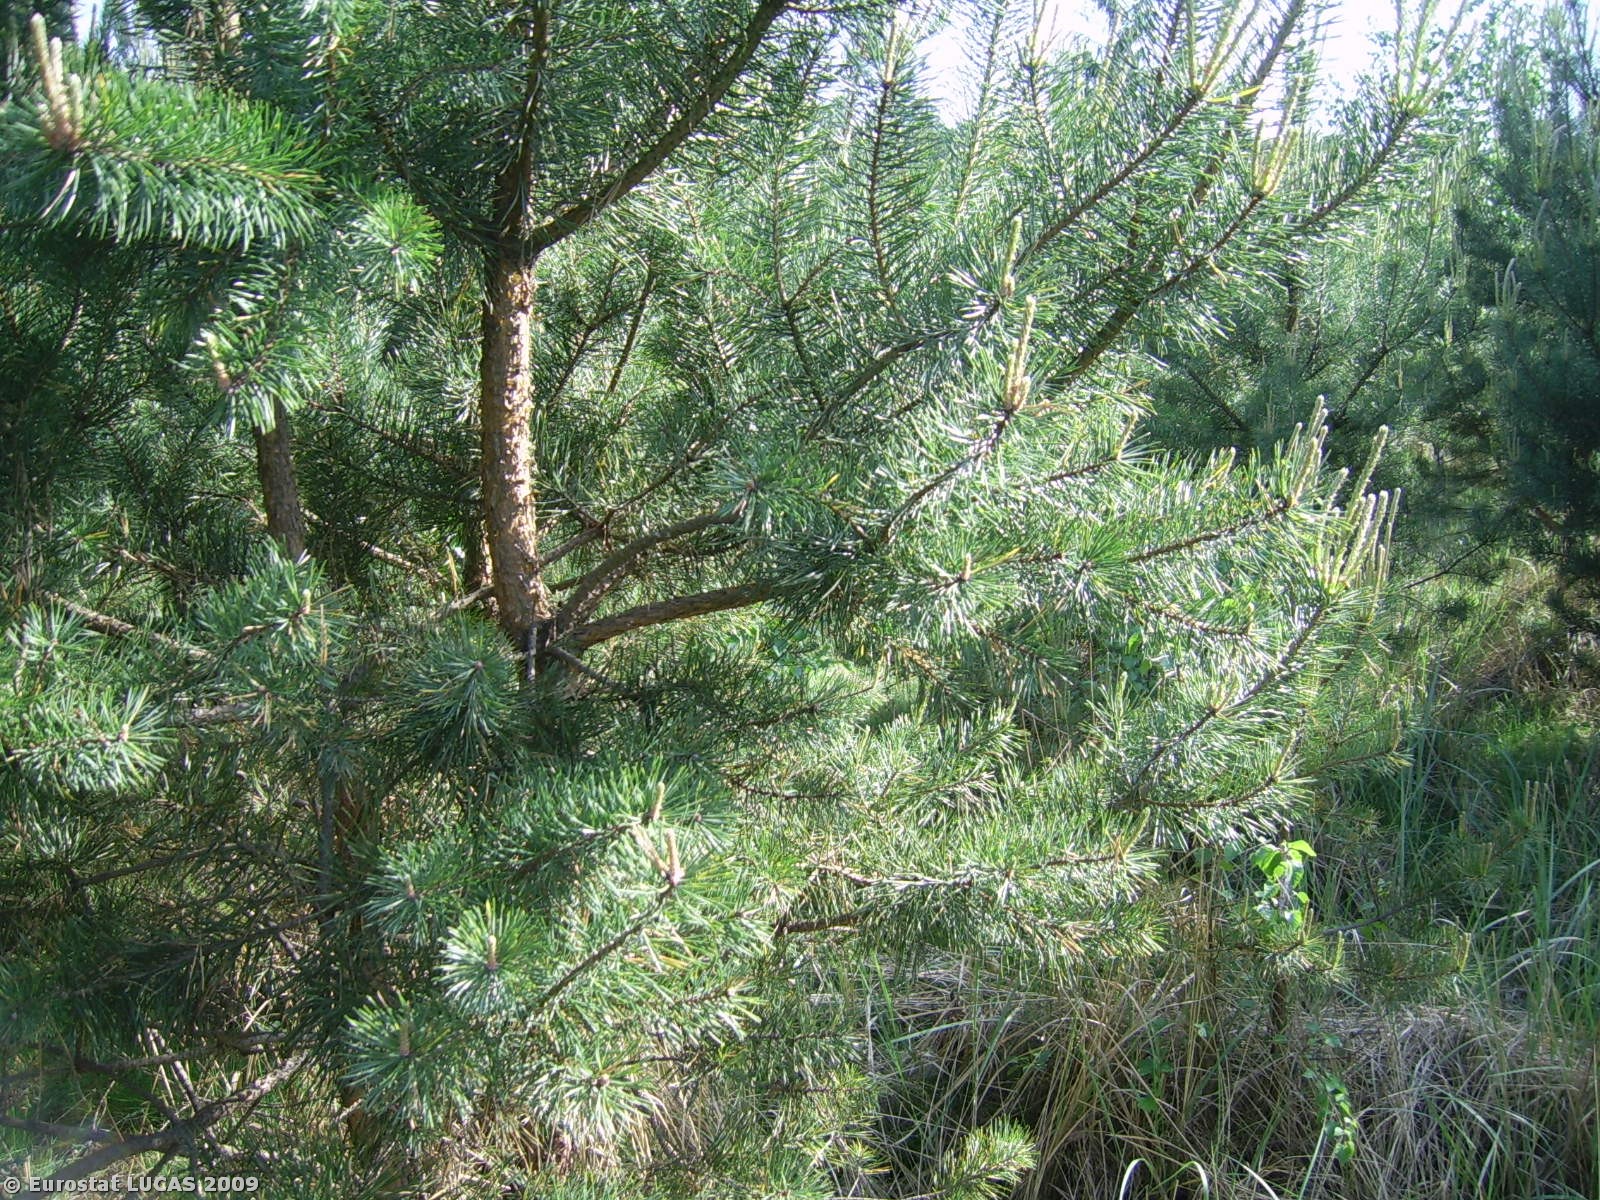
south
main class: Woodland
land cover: Mixed woodland
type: hemiboreal forest and nemoral coniferous forest and mixed broadleaved-coniferous forest
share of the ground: > 75 %
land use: Forestry
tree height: > 5 m
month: May
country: PL
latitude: 52.9795
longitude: 18.1931
